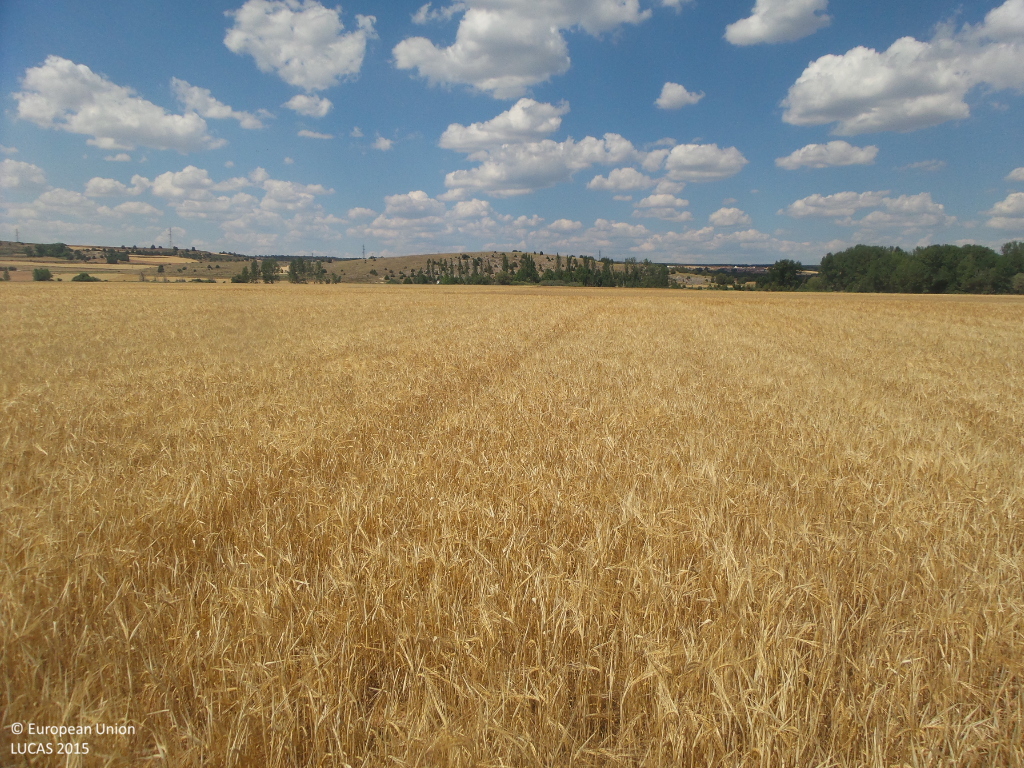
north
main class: Cropland
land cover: Barley
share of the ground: > 75 %
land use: Agriculture (excluding fallow land and kitchen gardens)
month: June
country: ES
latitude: 41.4849
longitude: -2.9880
